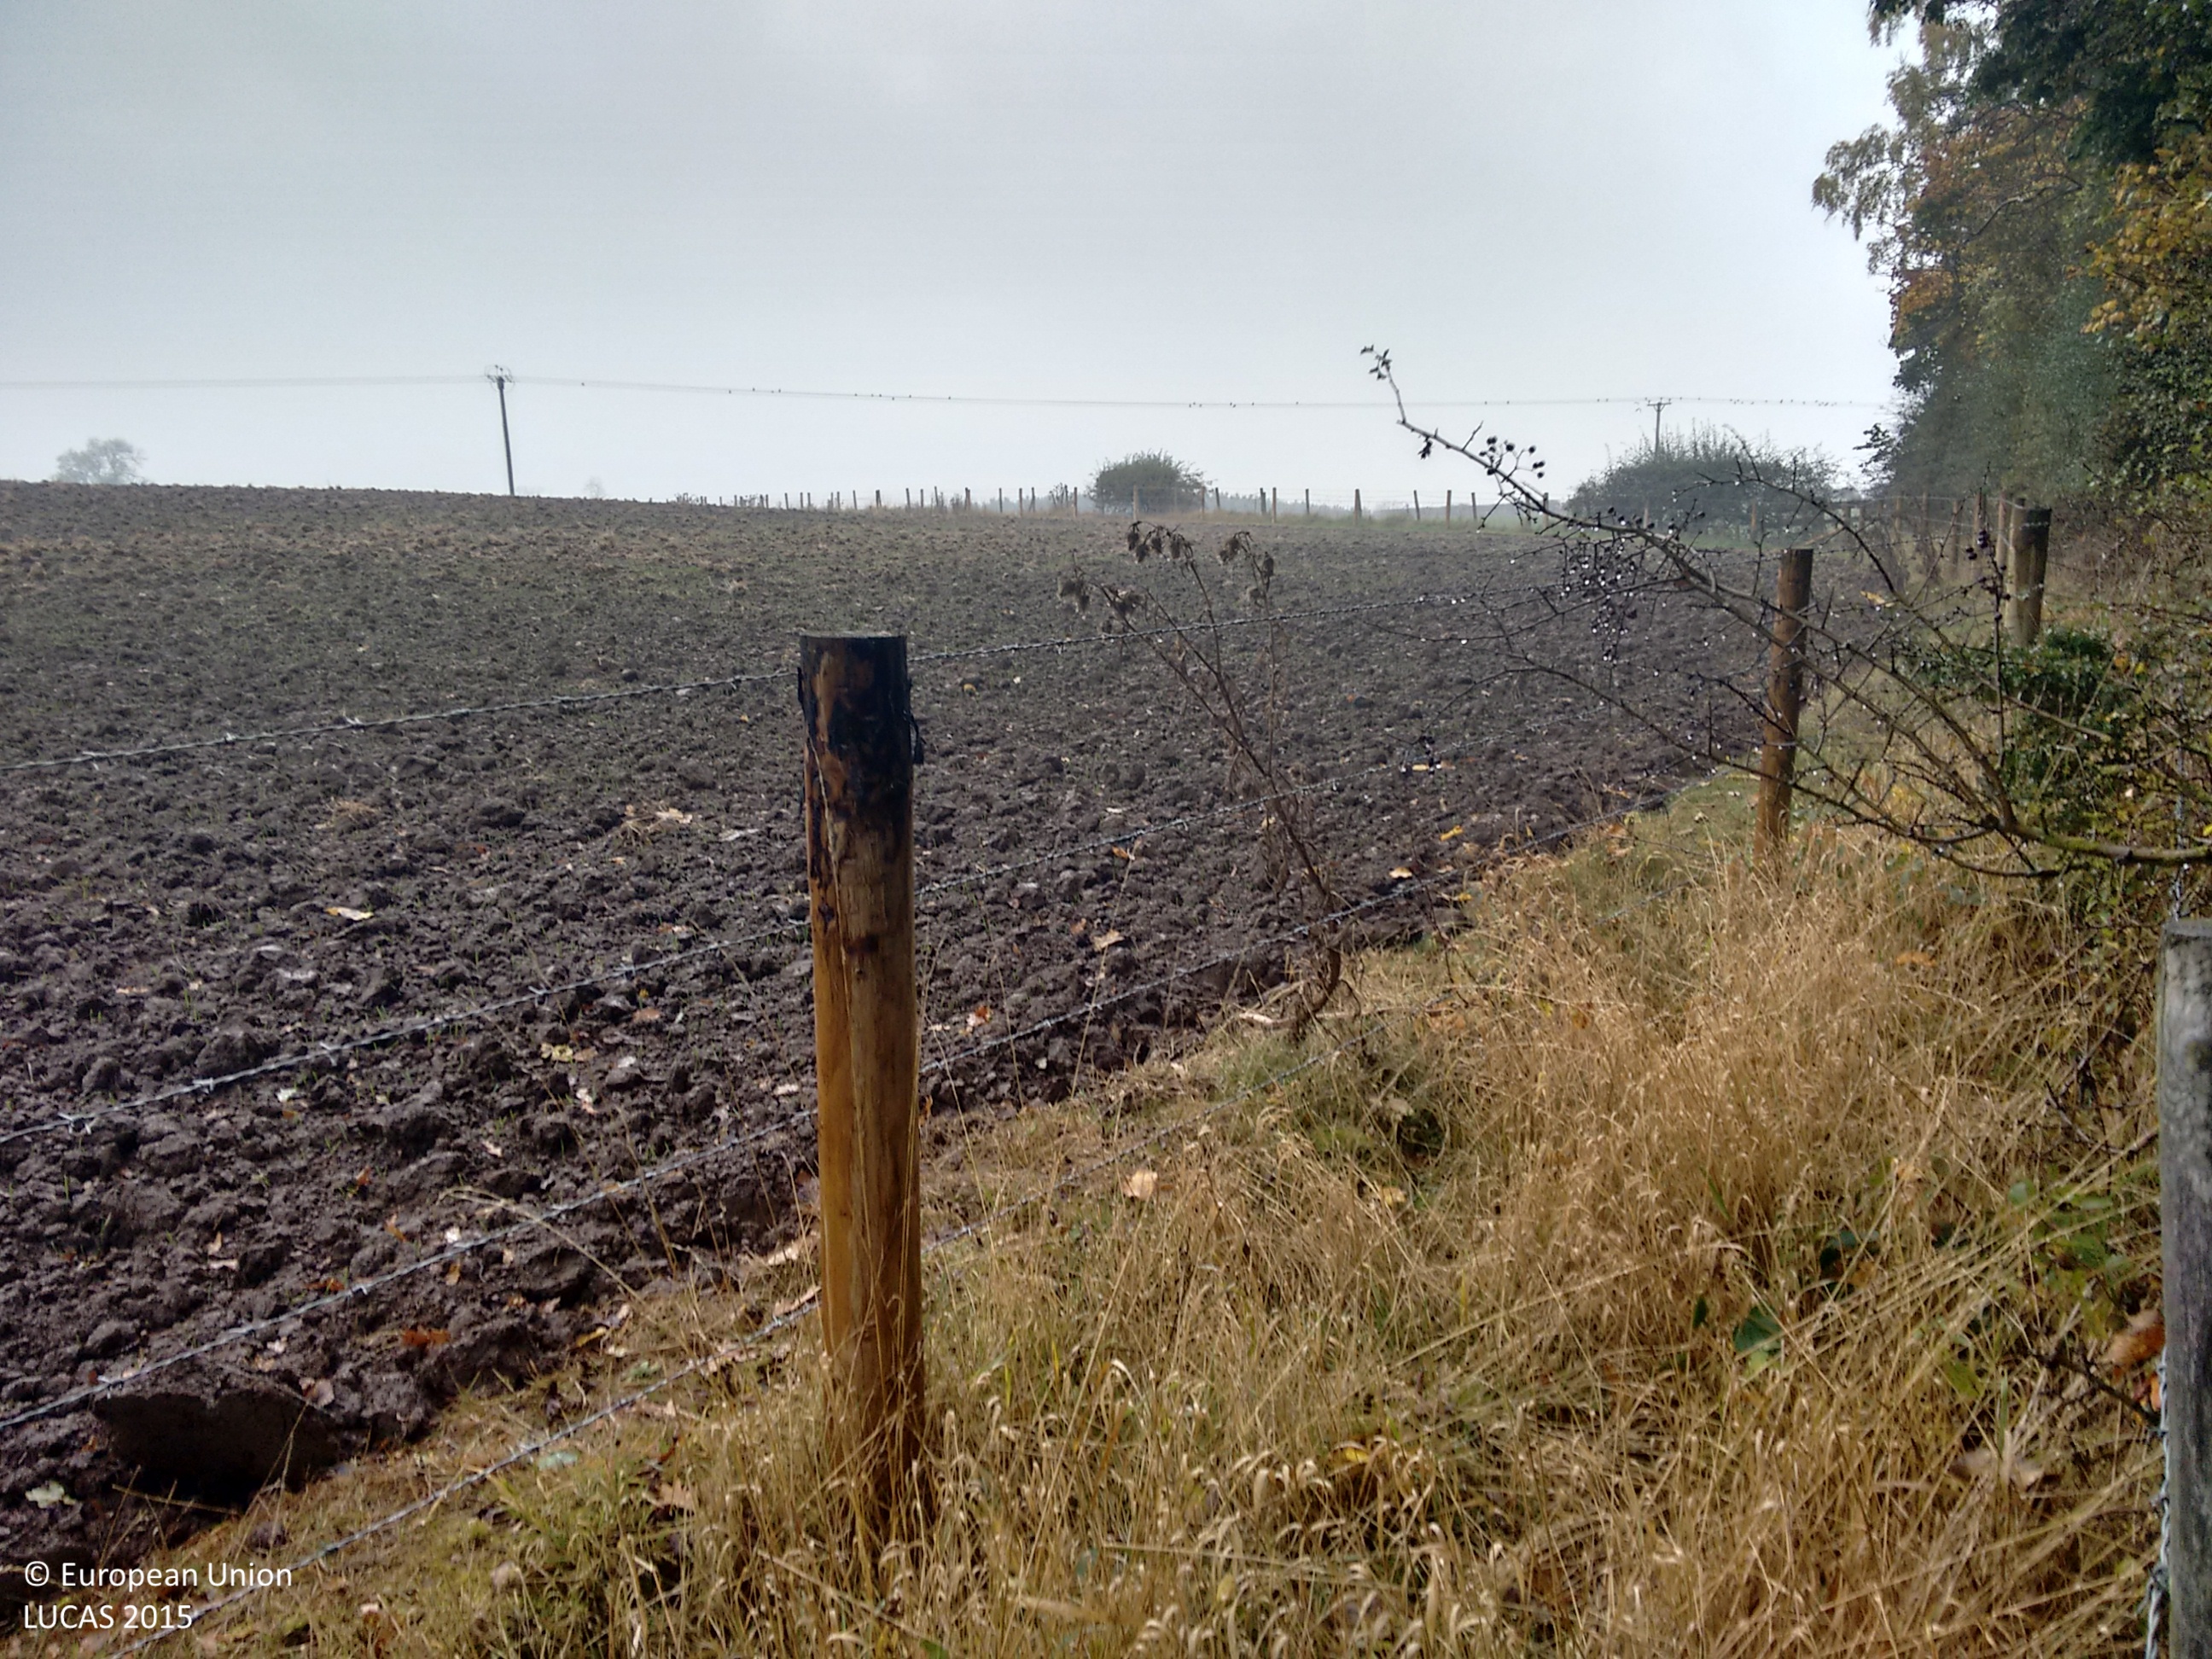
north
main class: Cropland
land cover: Common wheat
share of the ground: < 10 %
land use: Agriculture (excluding fallow land and kitchen gardens)
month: October
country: GB
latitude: 54.5324
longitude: -1.4055
